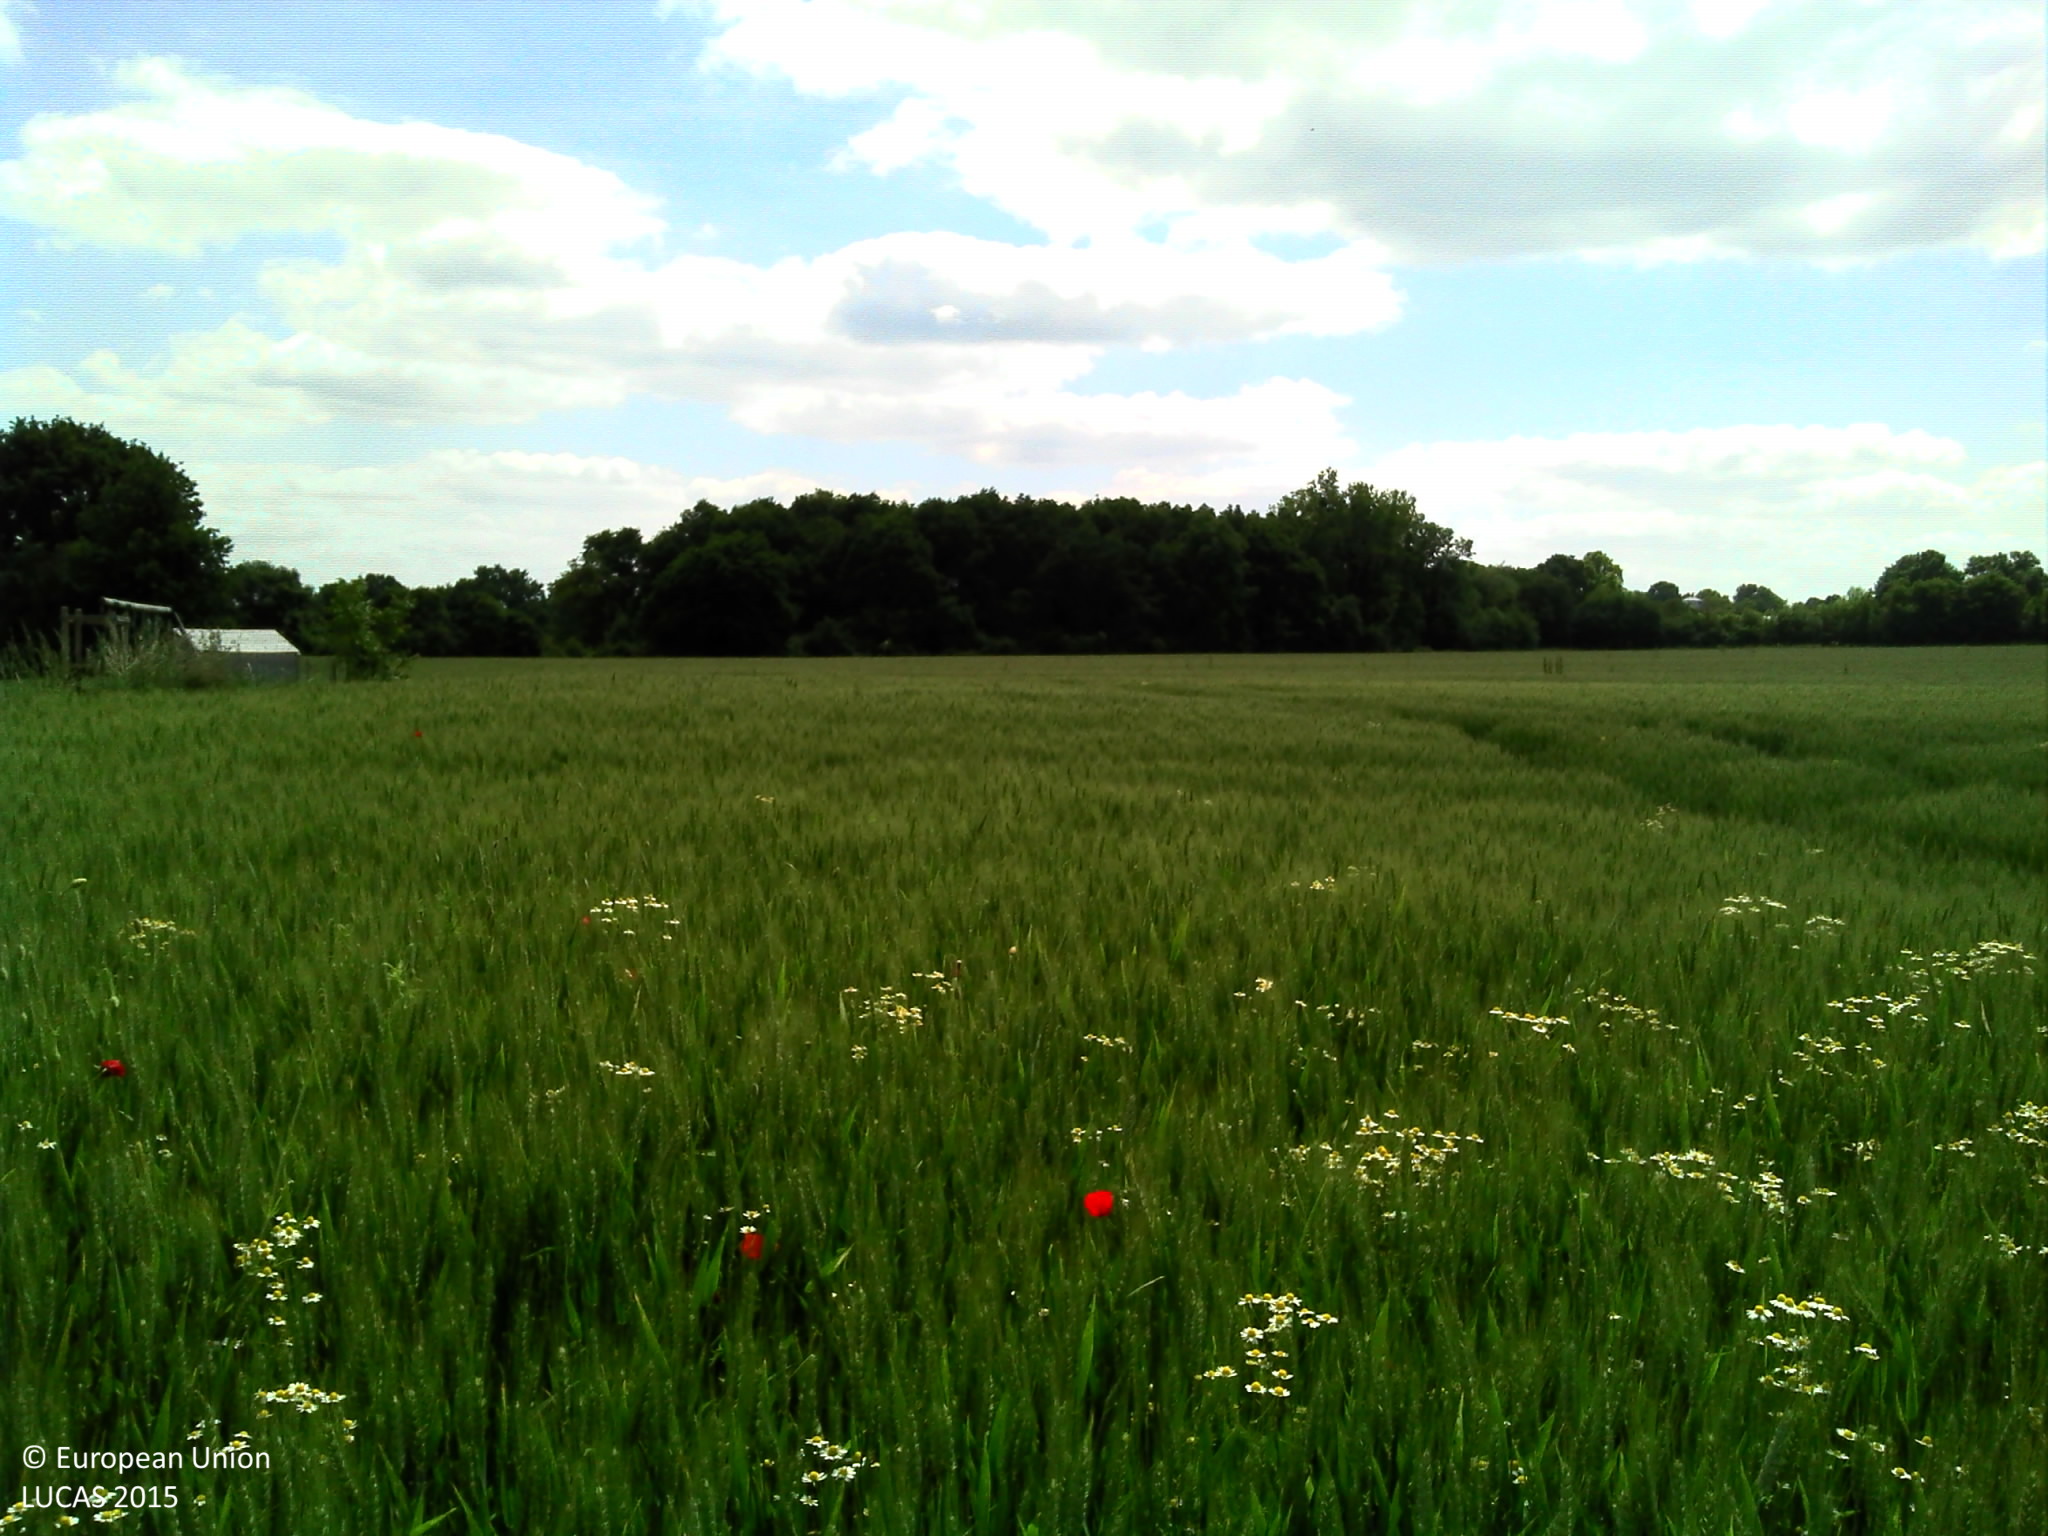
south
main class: Cropland
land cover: Common wheat
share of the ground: > 75 %
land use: Agriculture (excluding fallow land and kitchen gardens)
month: May
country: FR
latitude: 47.2554
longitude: 2.9251
